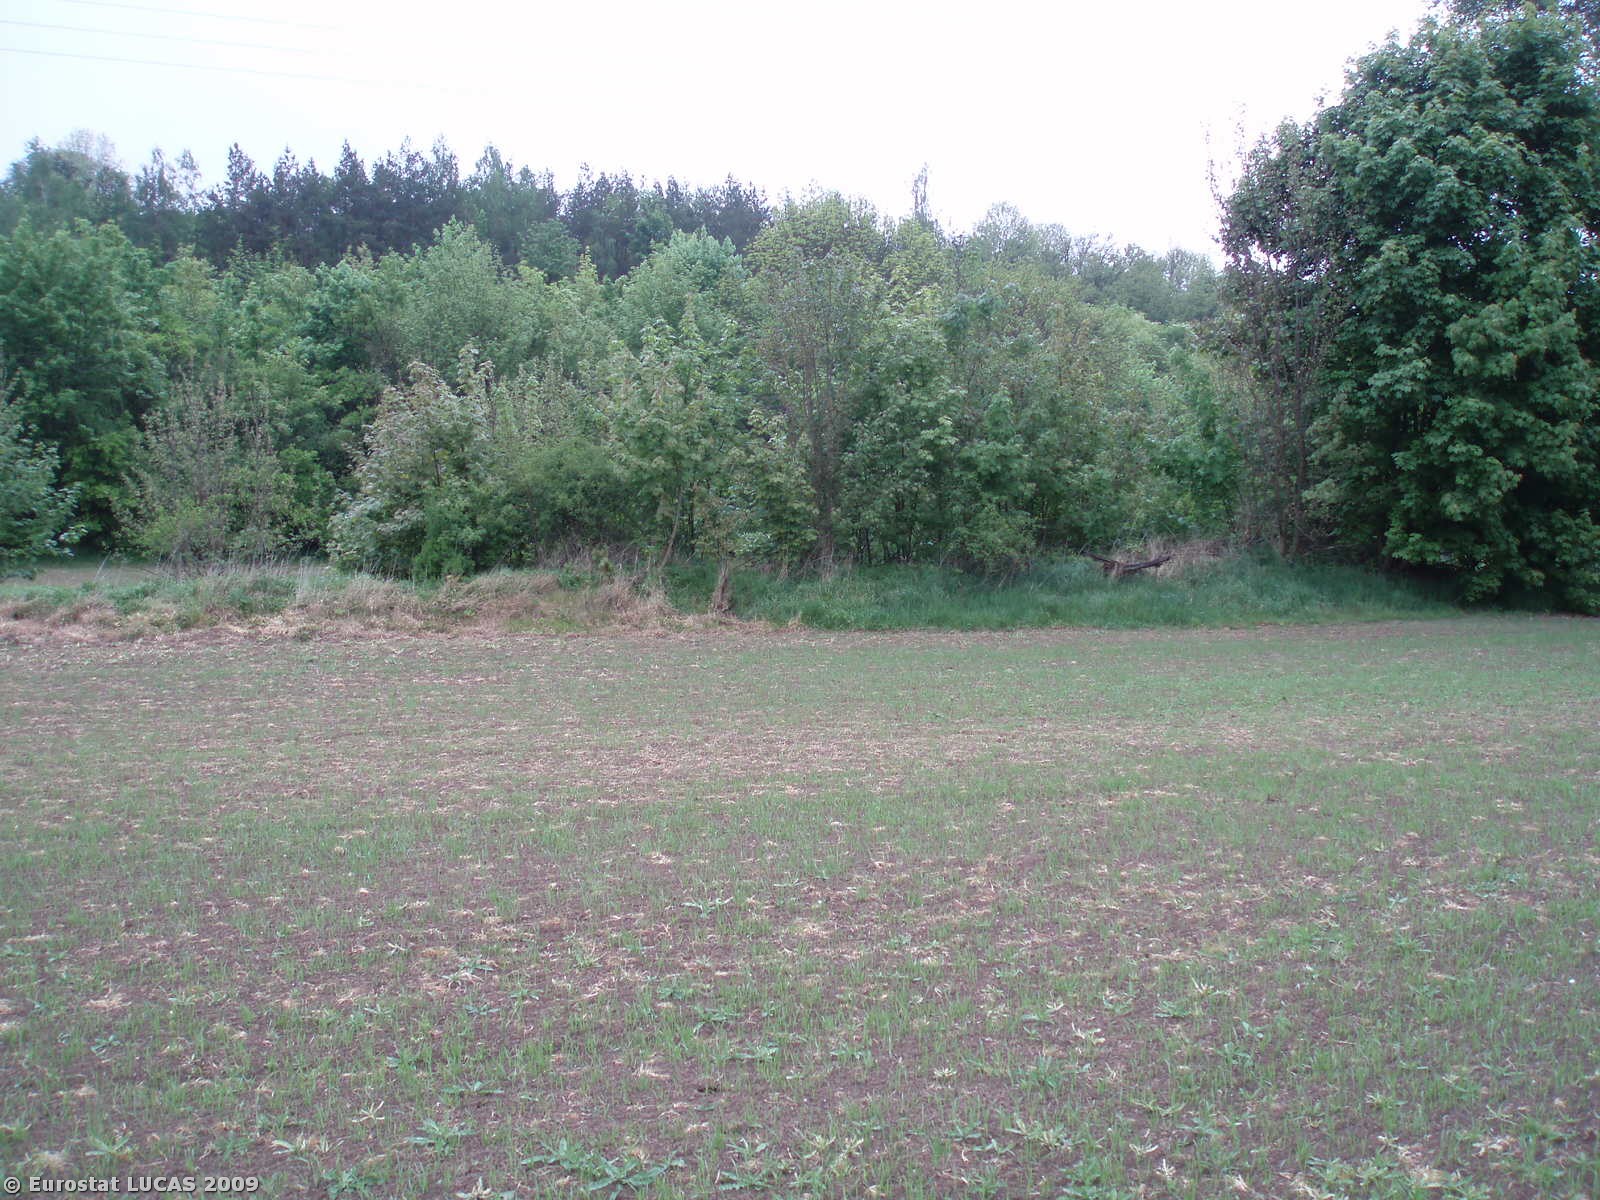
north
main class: Cropland
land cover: Common wheat
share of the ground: 25 - 50 %
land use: Agriculture (excluding fallow land and kitchen gardens)
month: May
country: CZ
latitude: 50.2004
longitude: 14.1059
